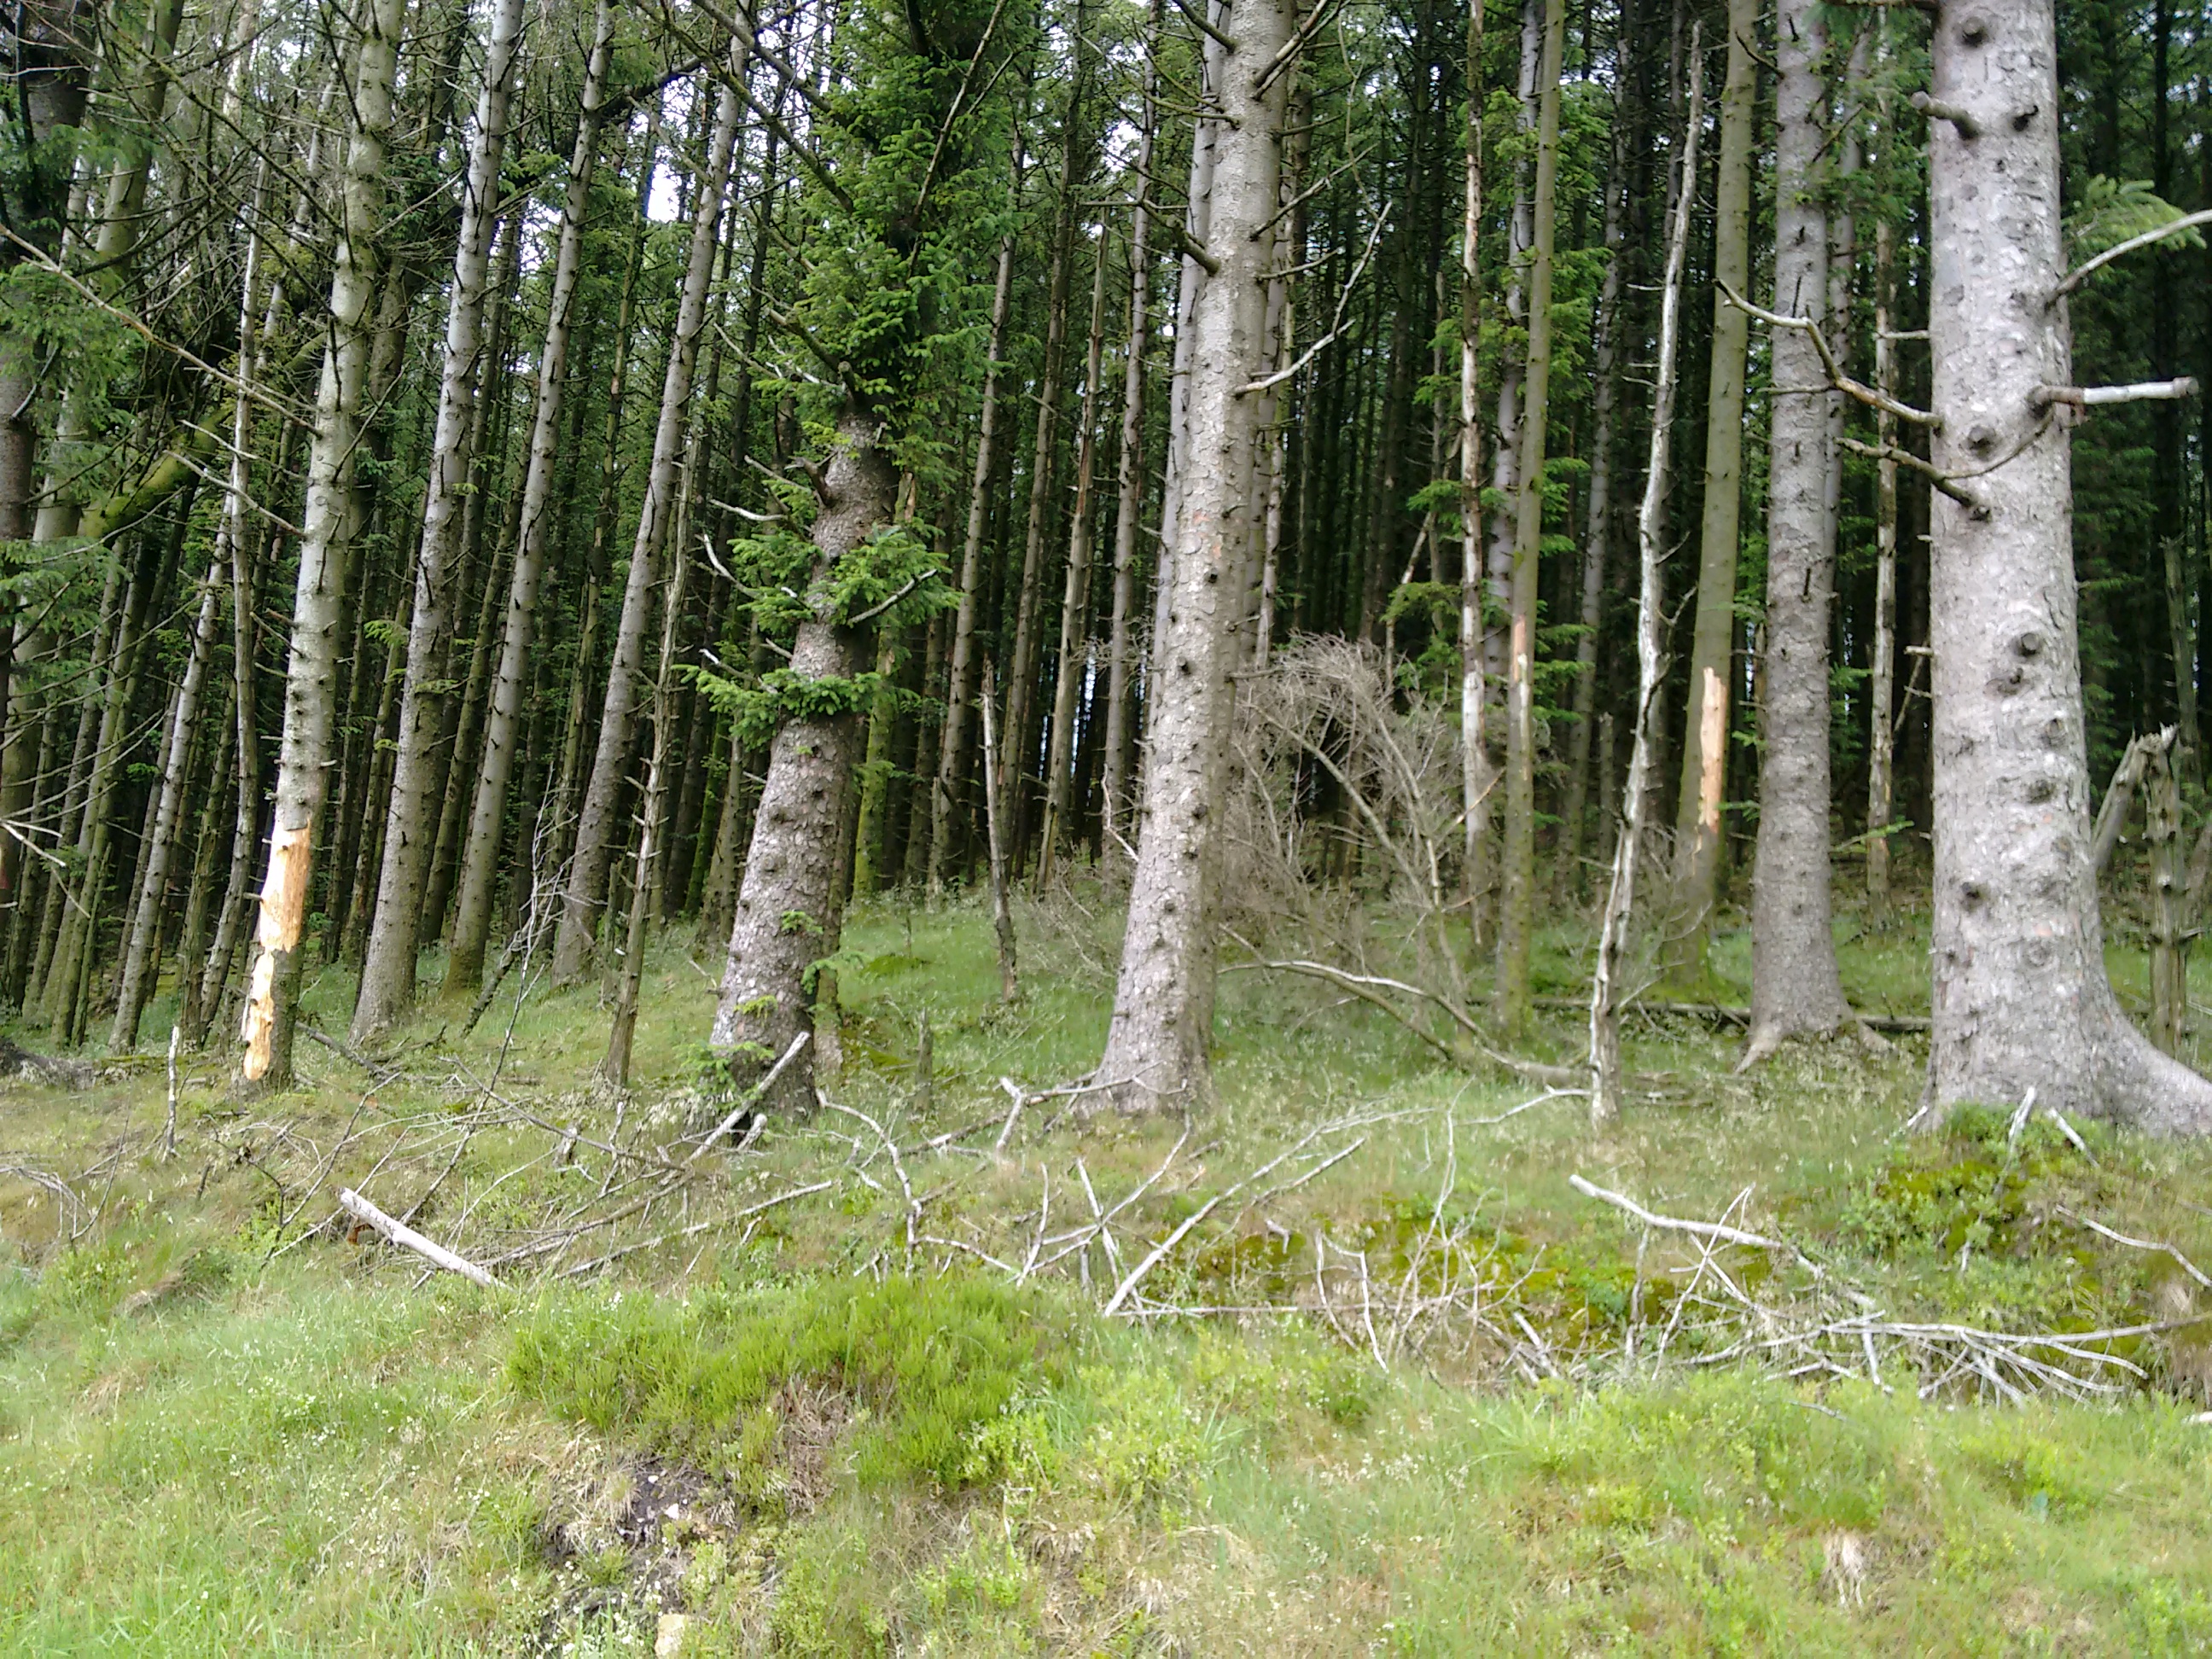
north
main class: Woodland
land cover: Spruce dominated coniferous woodland
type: exotic forest
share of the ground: > 75 %
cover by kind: coniferous forest trees 100 %
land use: Forestry
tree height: > 5 m
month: July
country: GB
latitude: 54.6779
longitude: -7.2213
